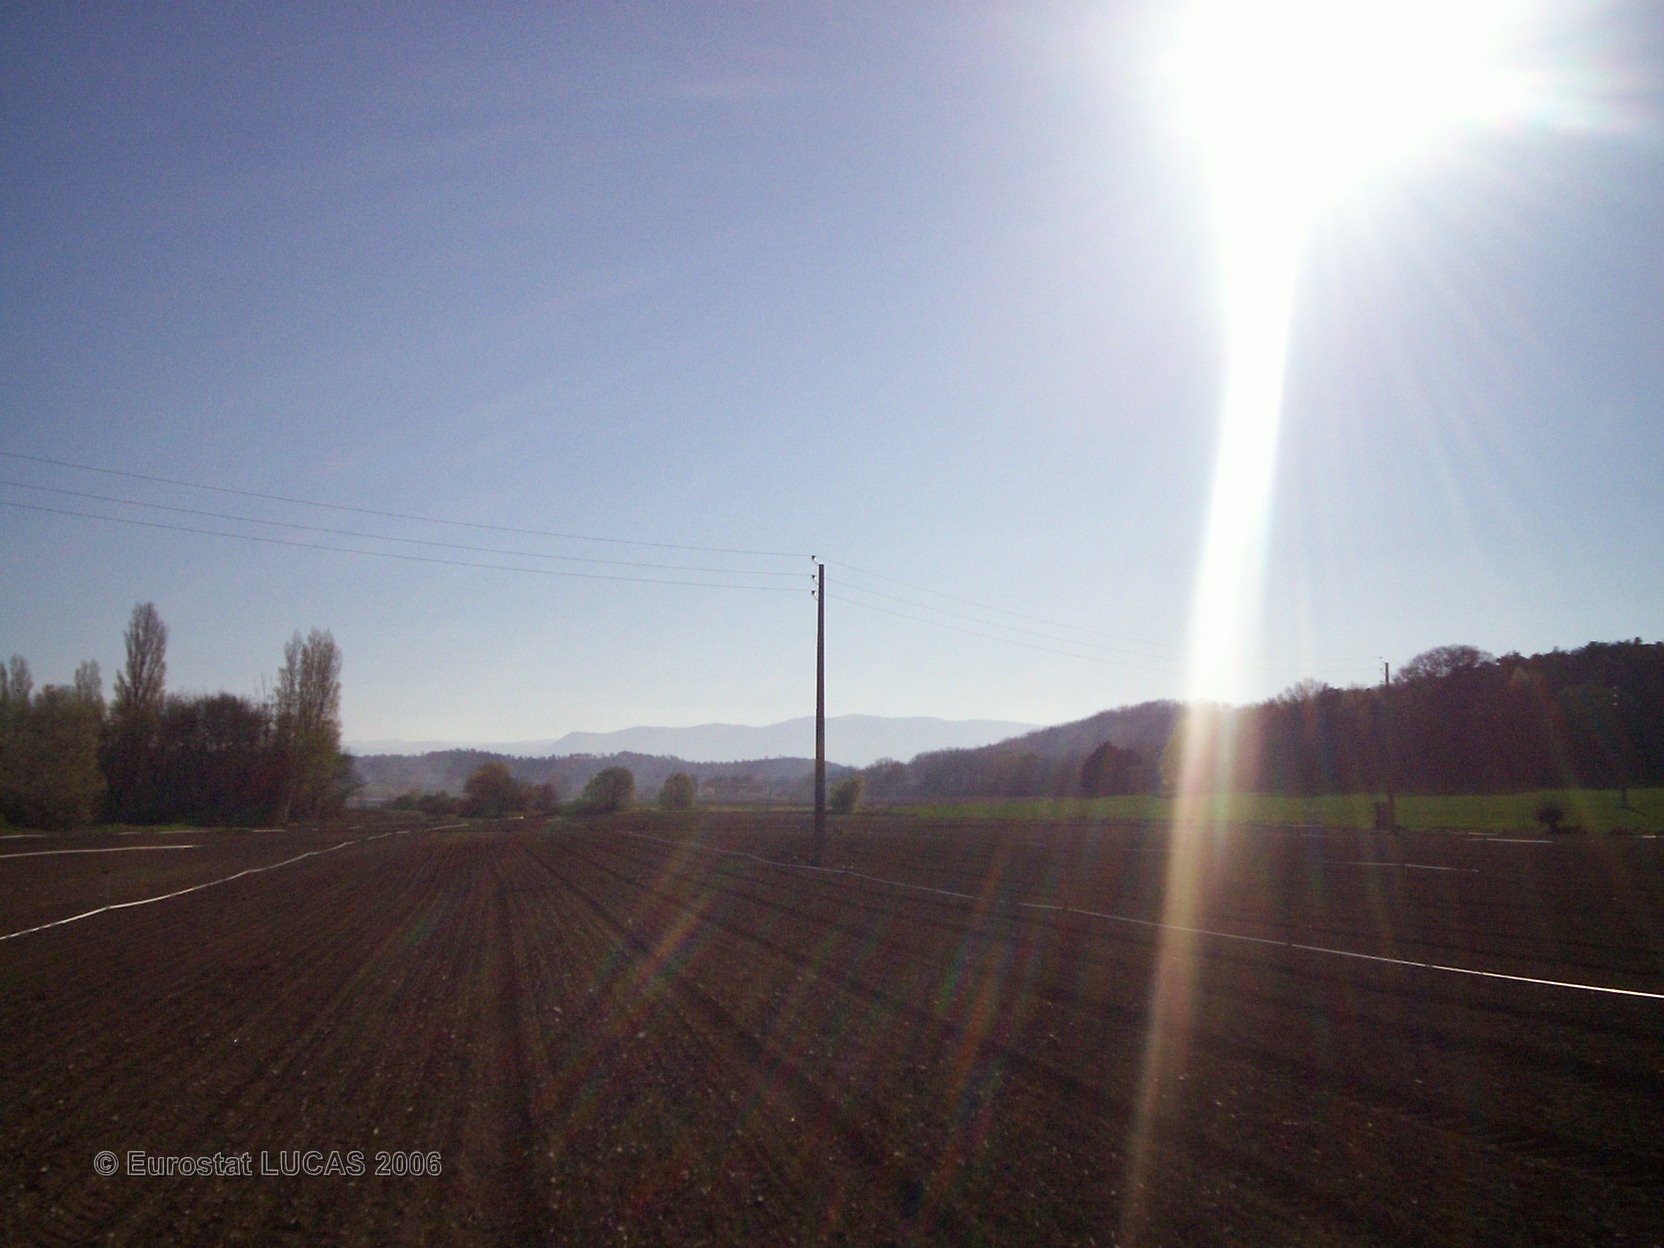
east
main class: Cropland
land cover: Other fresh vegetables
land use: Agriculture (excluding fallow land and kitchen gardens)
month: April
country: FR
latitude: 44.8038
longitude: 4.9110
